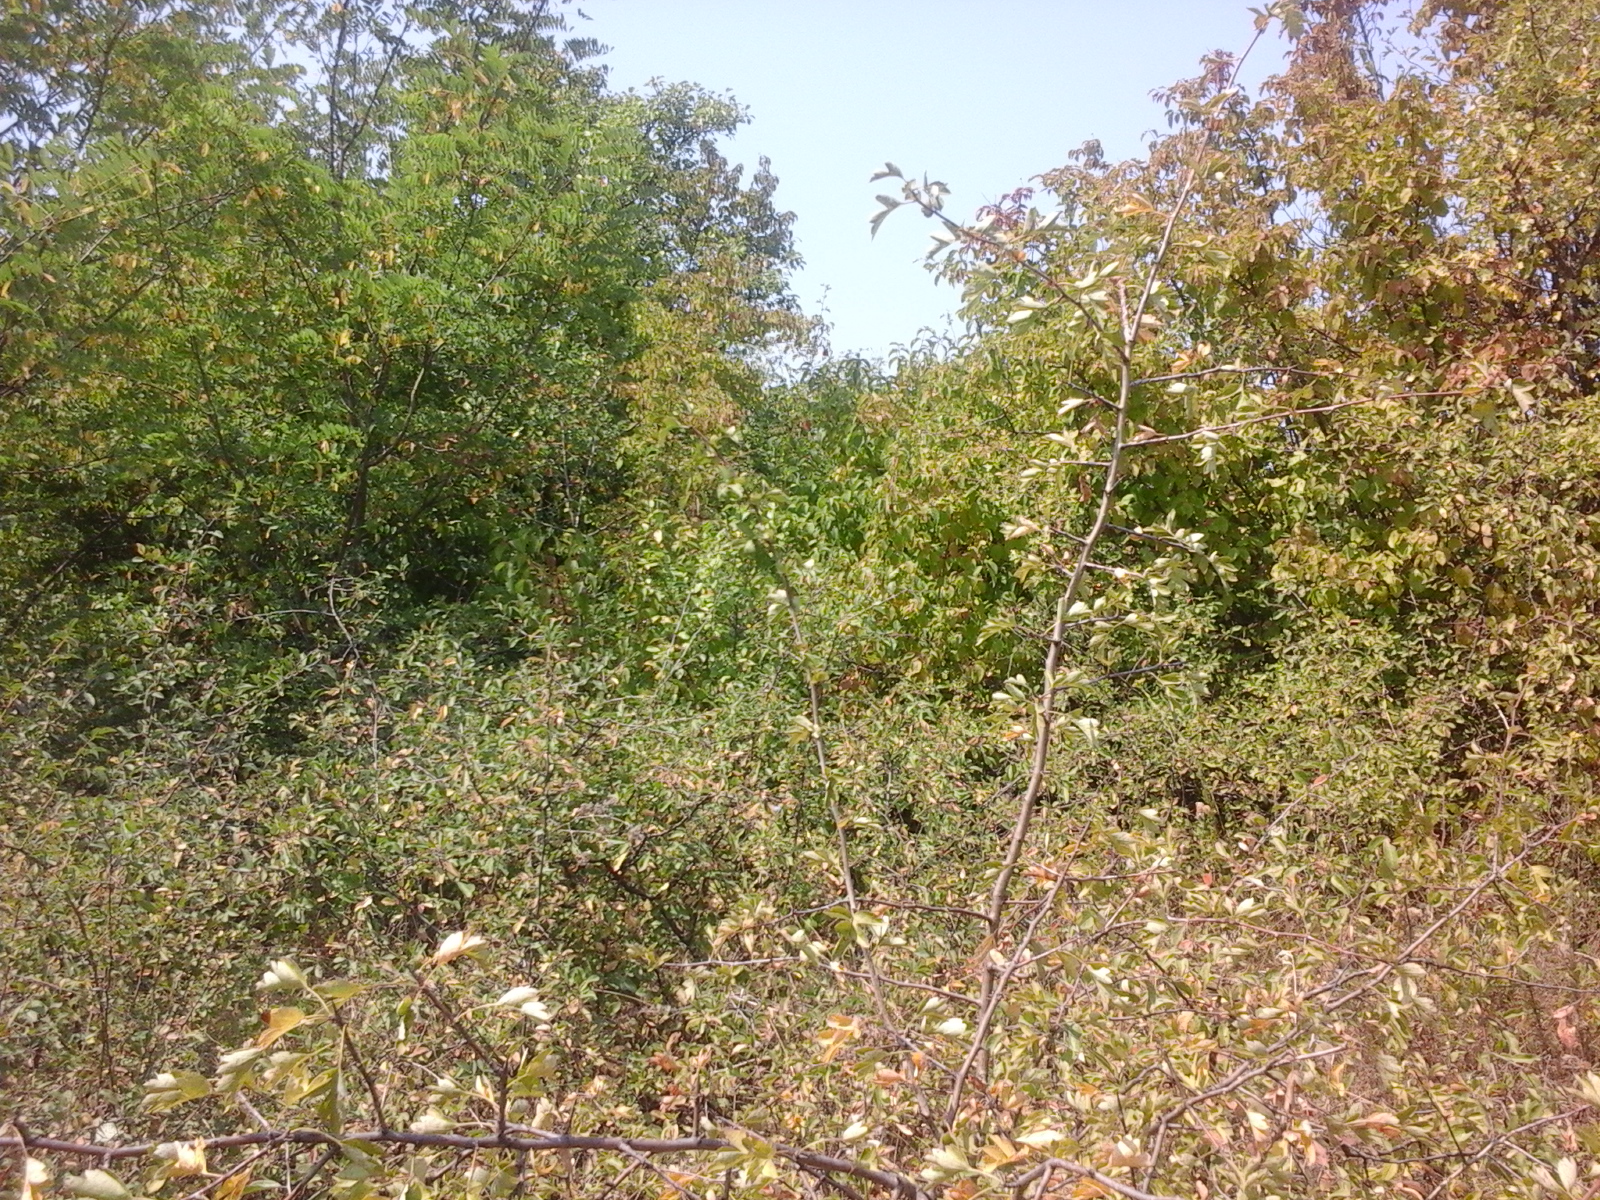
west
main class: Shrubland
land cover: Shrubland with sparse tree cover
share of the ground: > 75 %
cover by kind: shrubs 95 %, broadleaved forest trees 5 %
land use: Semi-natural and natural areas not in use
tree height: < 5 m
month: August
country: RO
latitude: 44.5452
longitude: 23.3299
